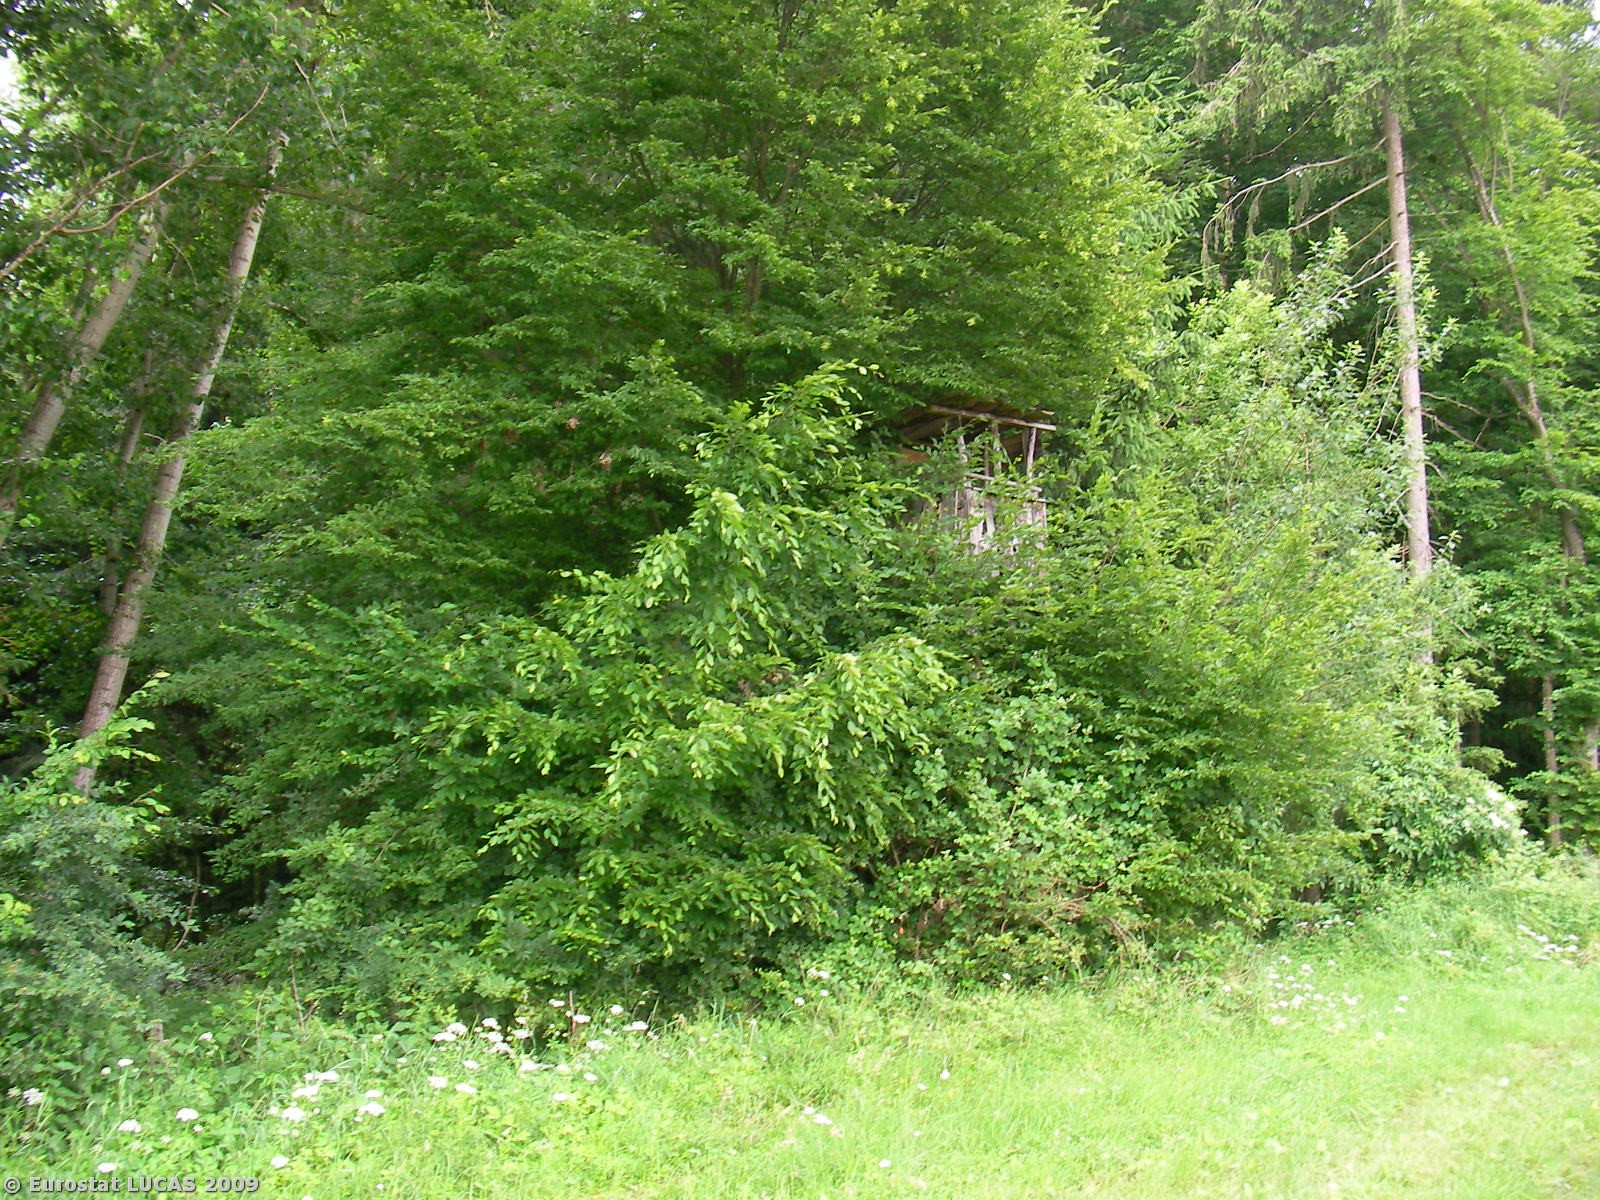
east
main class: Cropland
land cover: Maize
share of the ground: 10 - 25 %
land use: Agriculture (excluding fallow land and kitchen gardens)
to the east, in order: Maize; Tracks; Mixed woodland; Tracks; Mixed woodland; Rivers and streams; Coniferous woodland; Grassland without tree/shrub cover; Fences; Apple fruit; Grassland with sparse tree/shrub cover
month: June
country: AT
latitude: 47.1539
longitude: 15.7379
